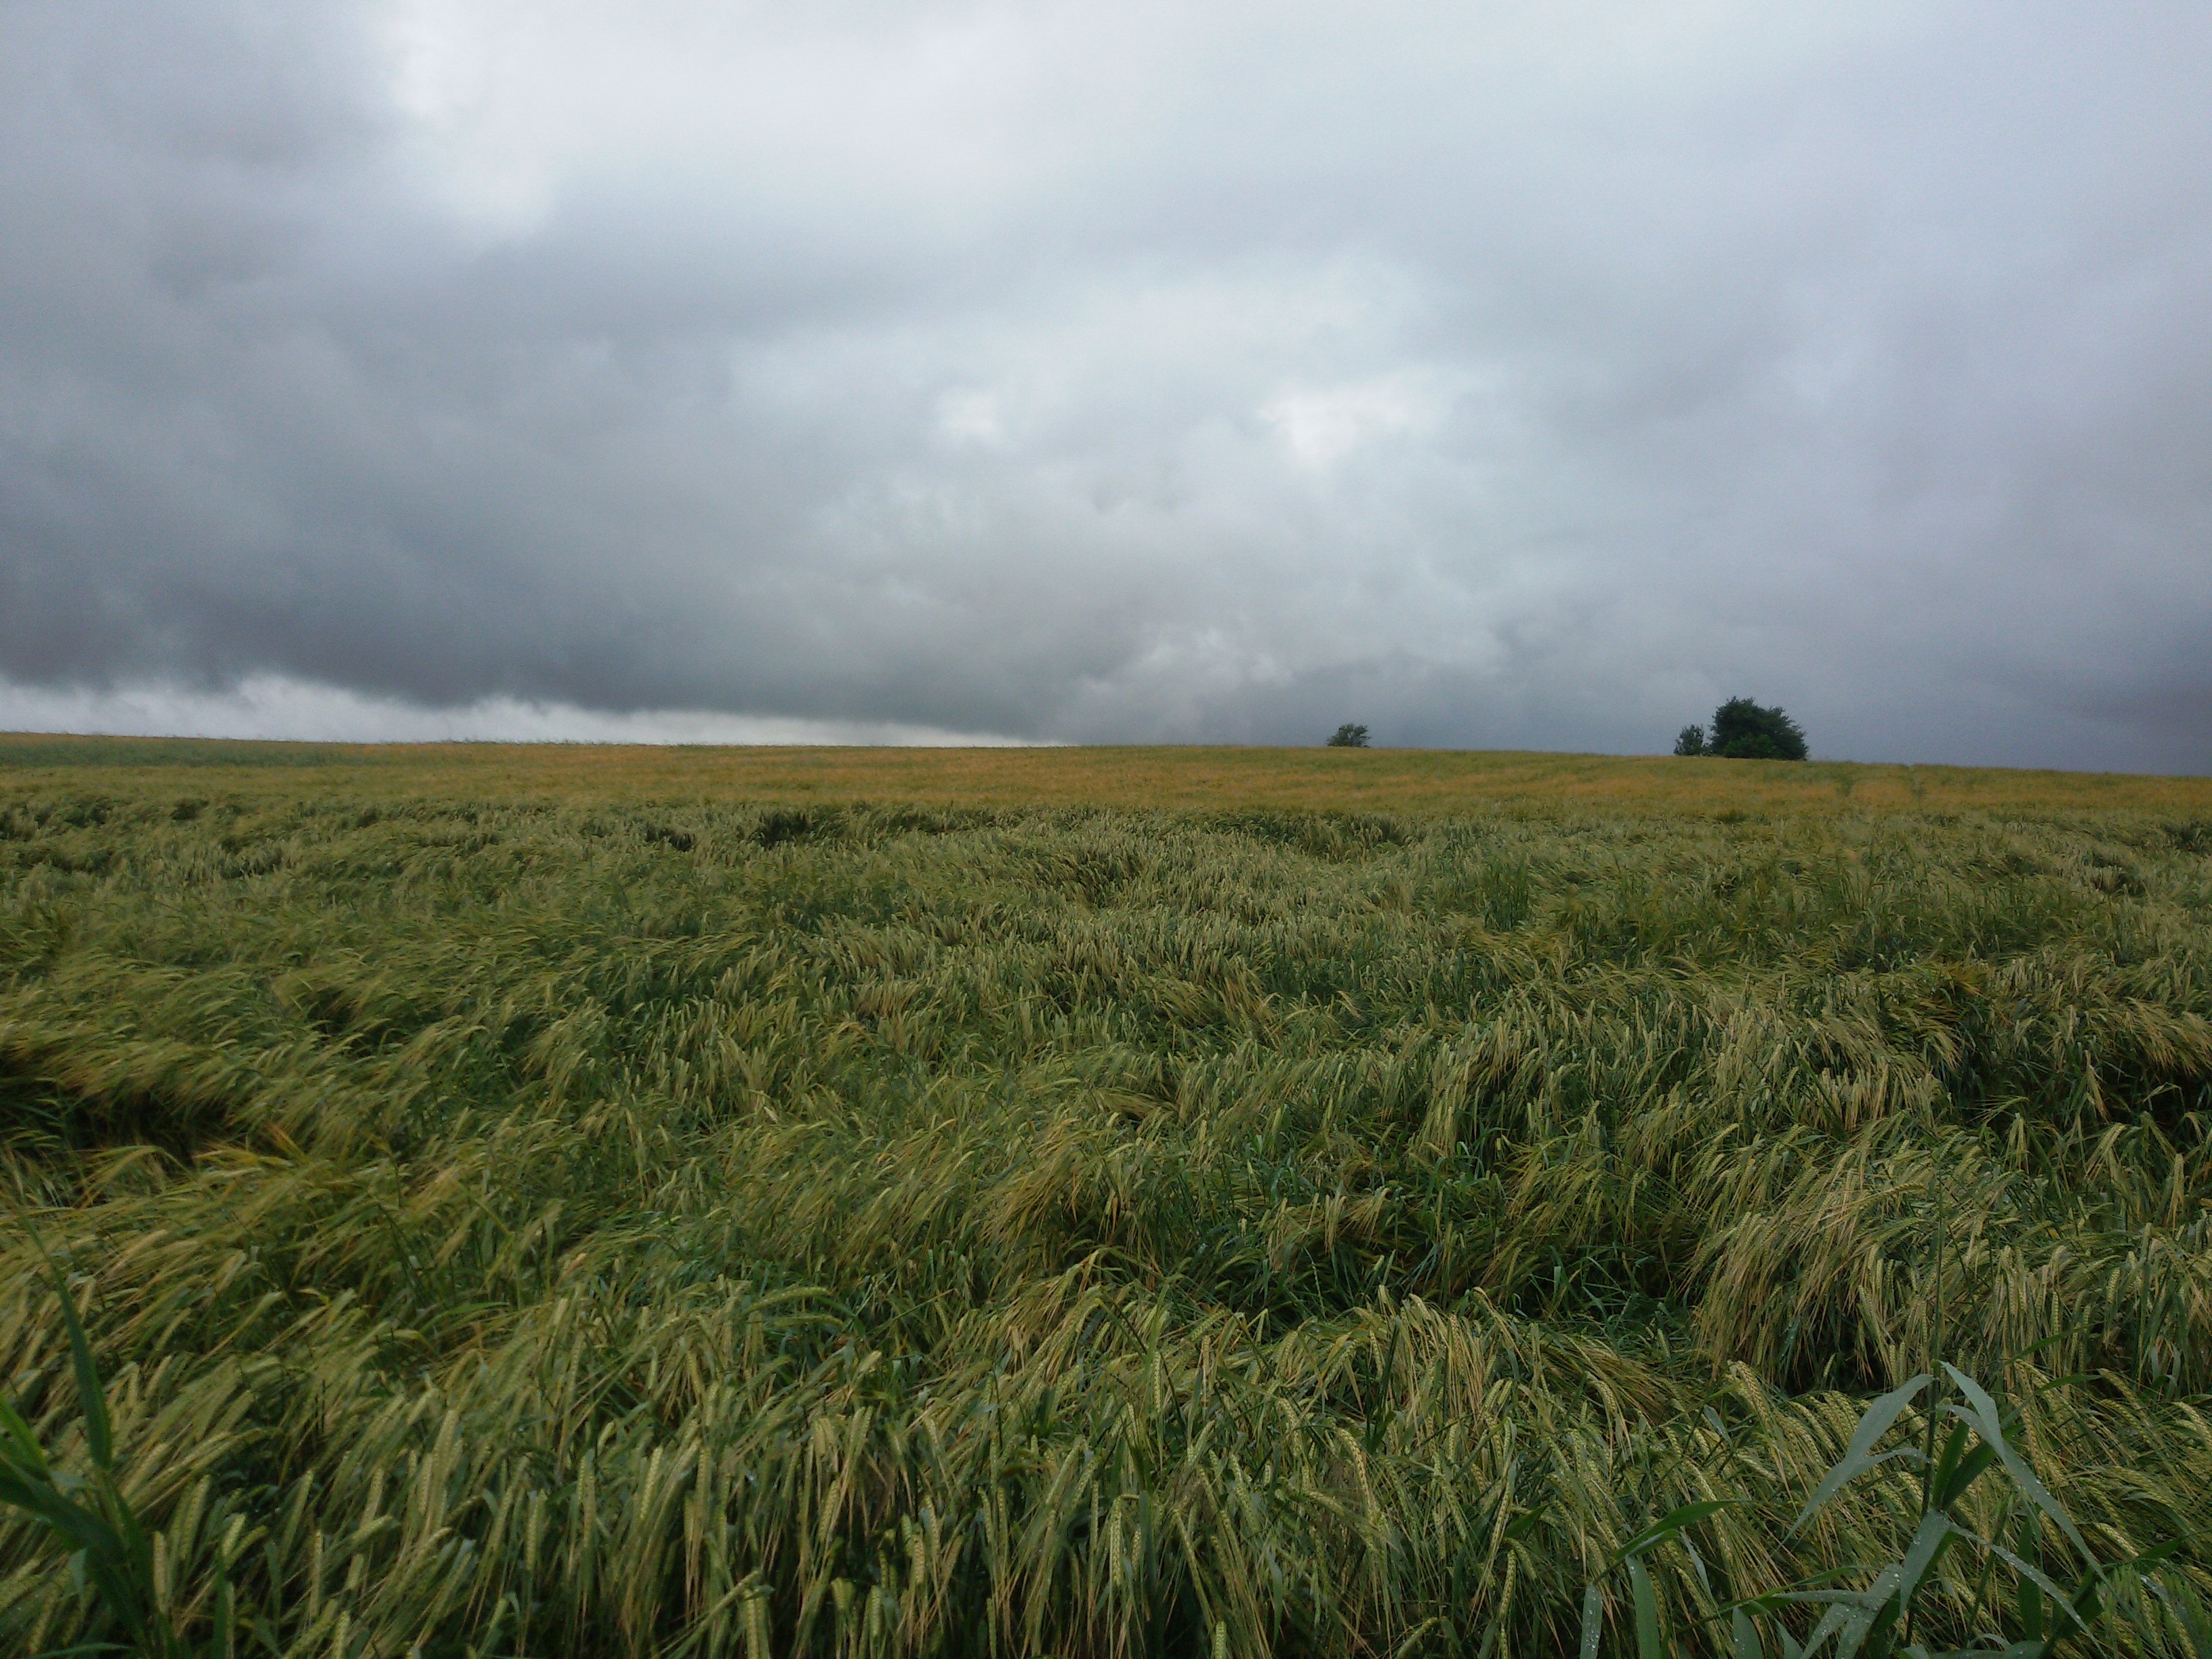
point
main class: Cropland
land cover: Barley
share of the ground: > 75 %
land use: Agriculture (excluding fallow land and kitchen gardens)
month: July
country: PL
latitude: 52.9113
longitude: 17.5816
